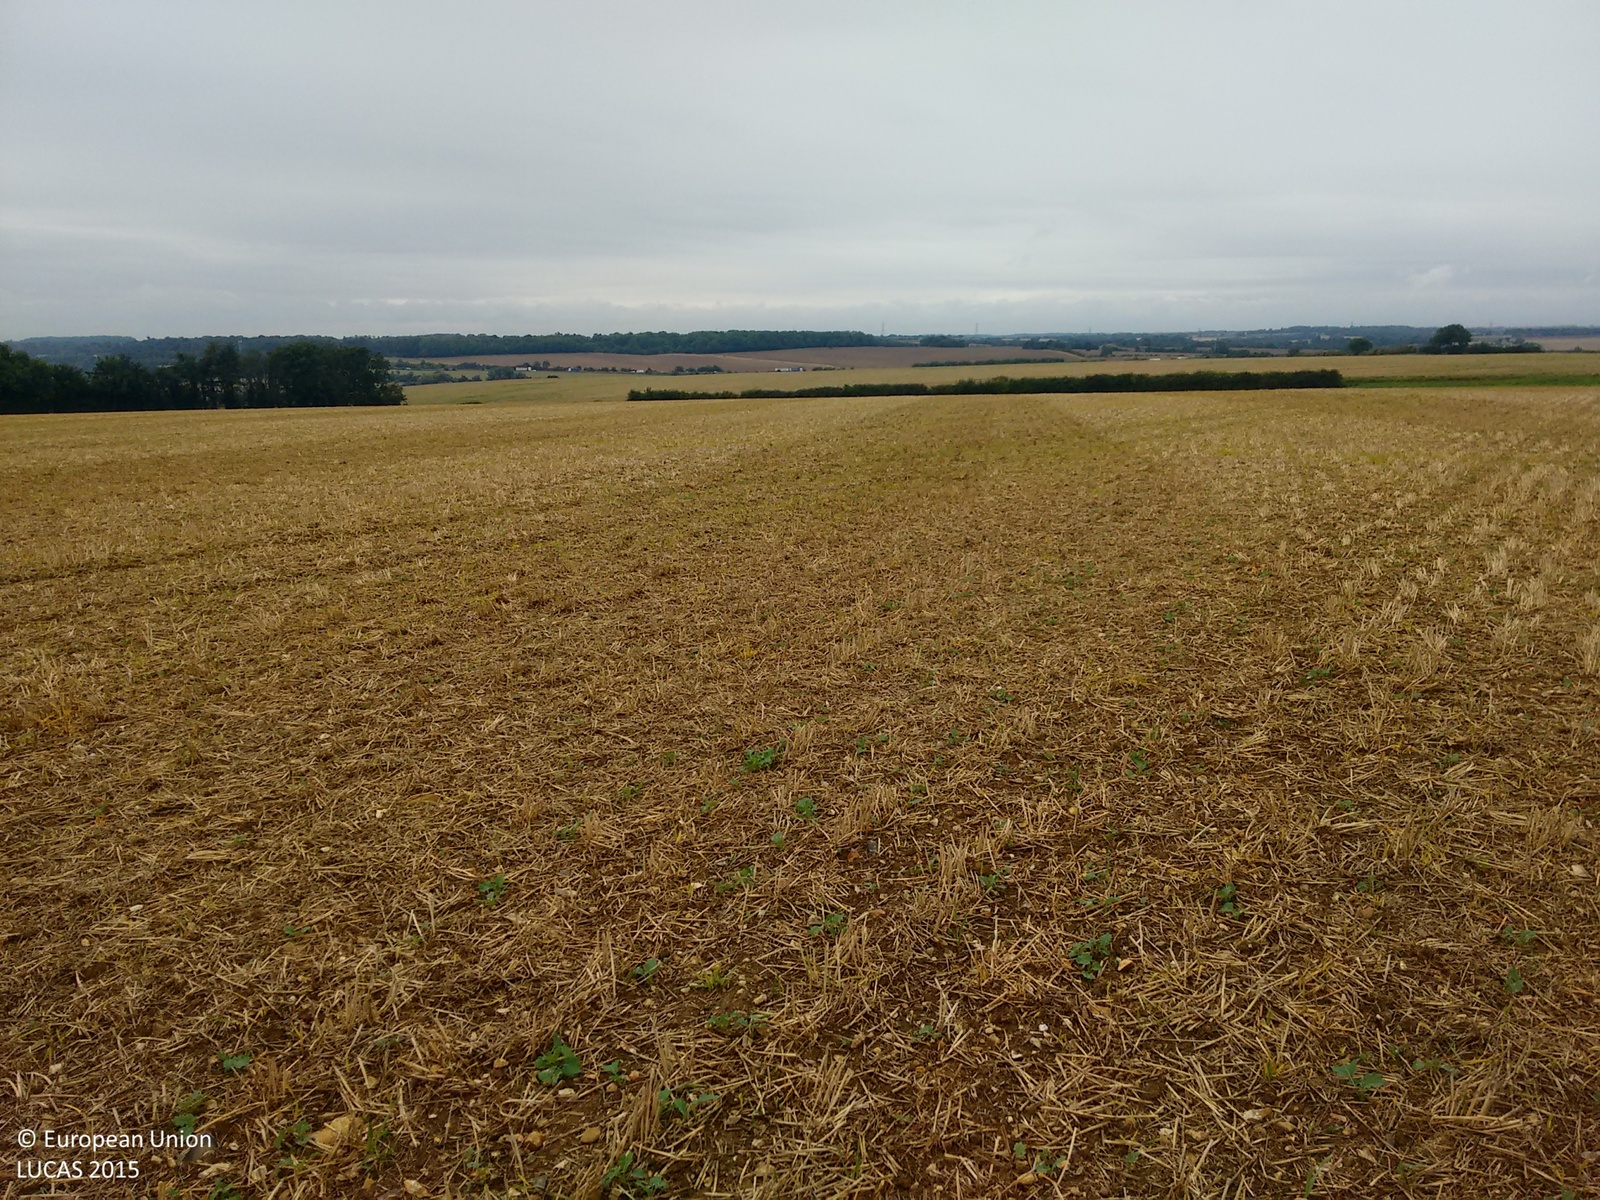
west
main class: Cropland
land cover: Common wheat
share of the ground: 50 - 75 %
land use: Agriculture (excluding fallow land and kitchen gardens)
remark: Harvested field
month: September
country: GB
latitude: 51.9736
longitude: 0.2308
